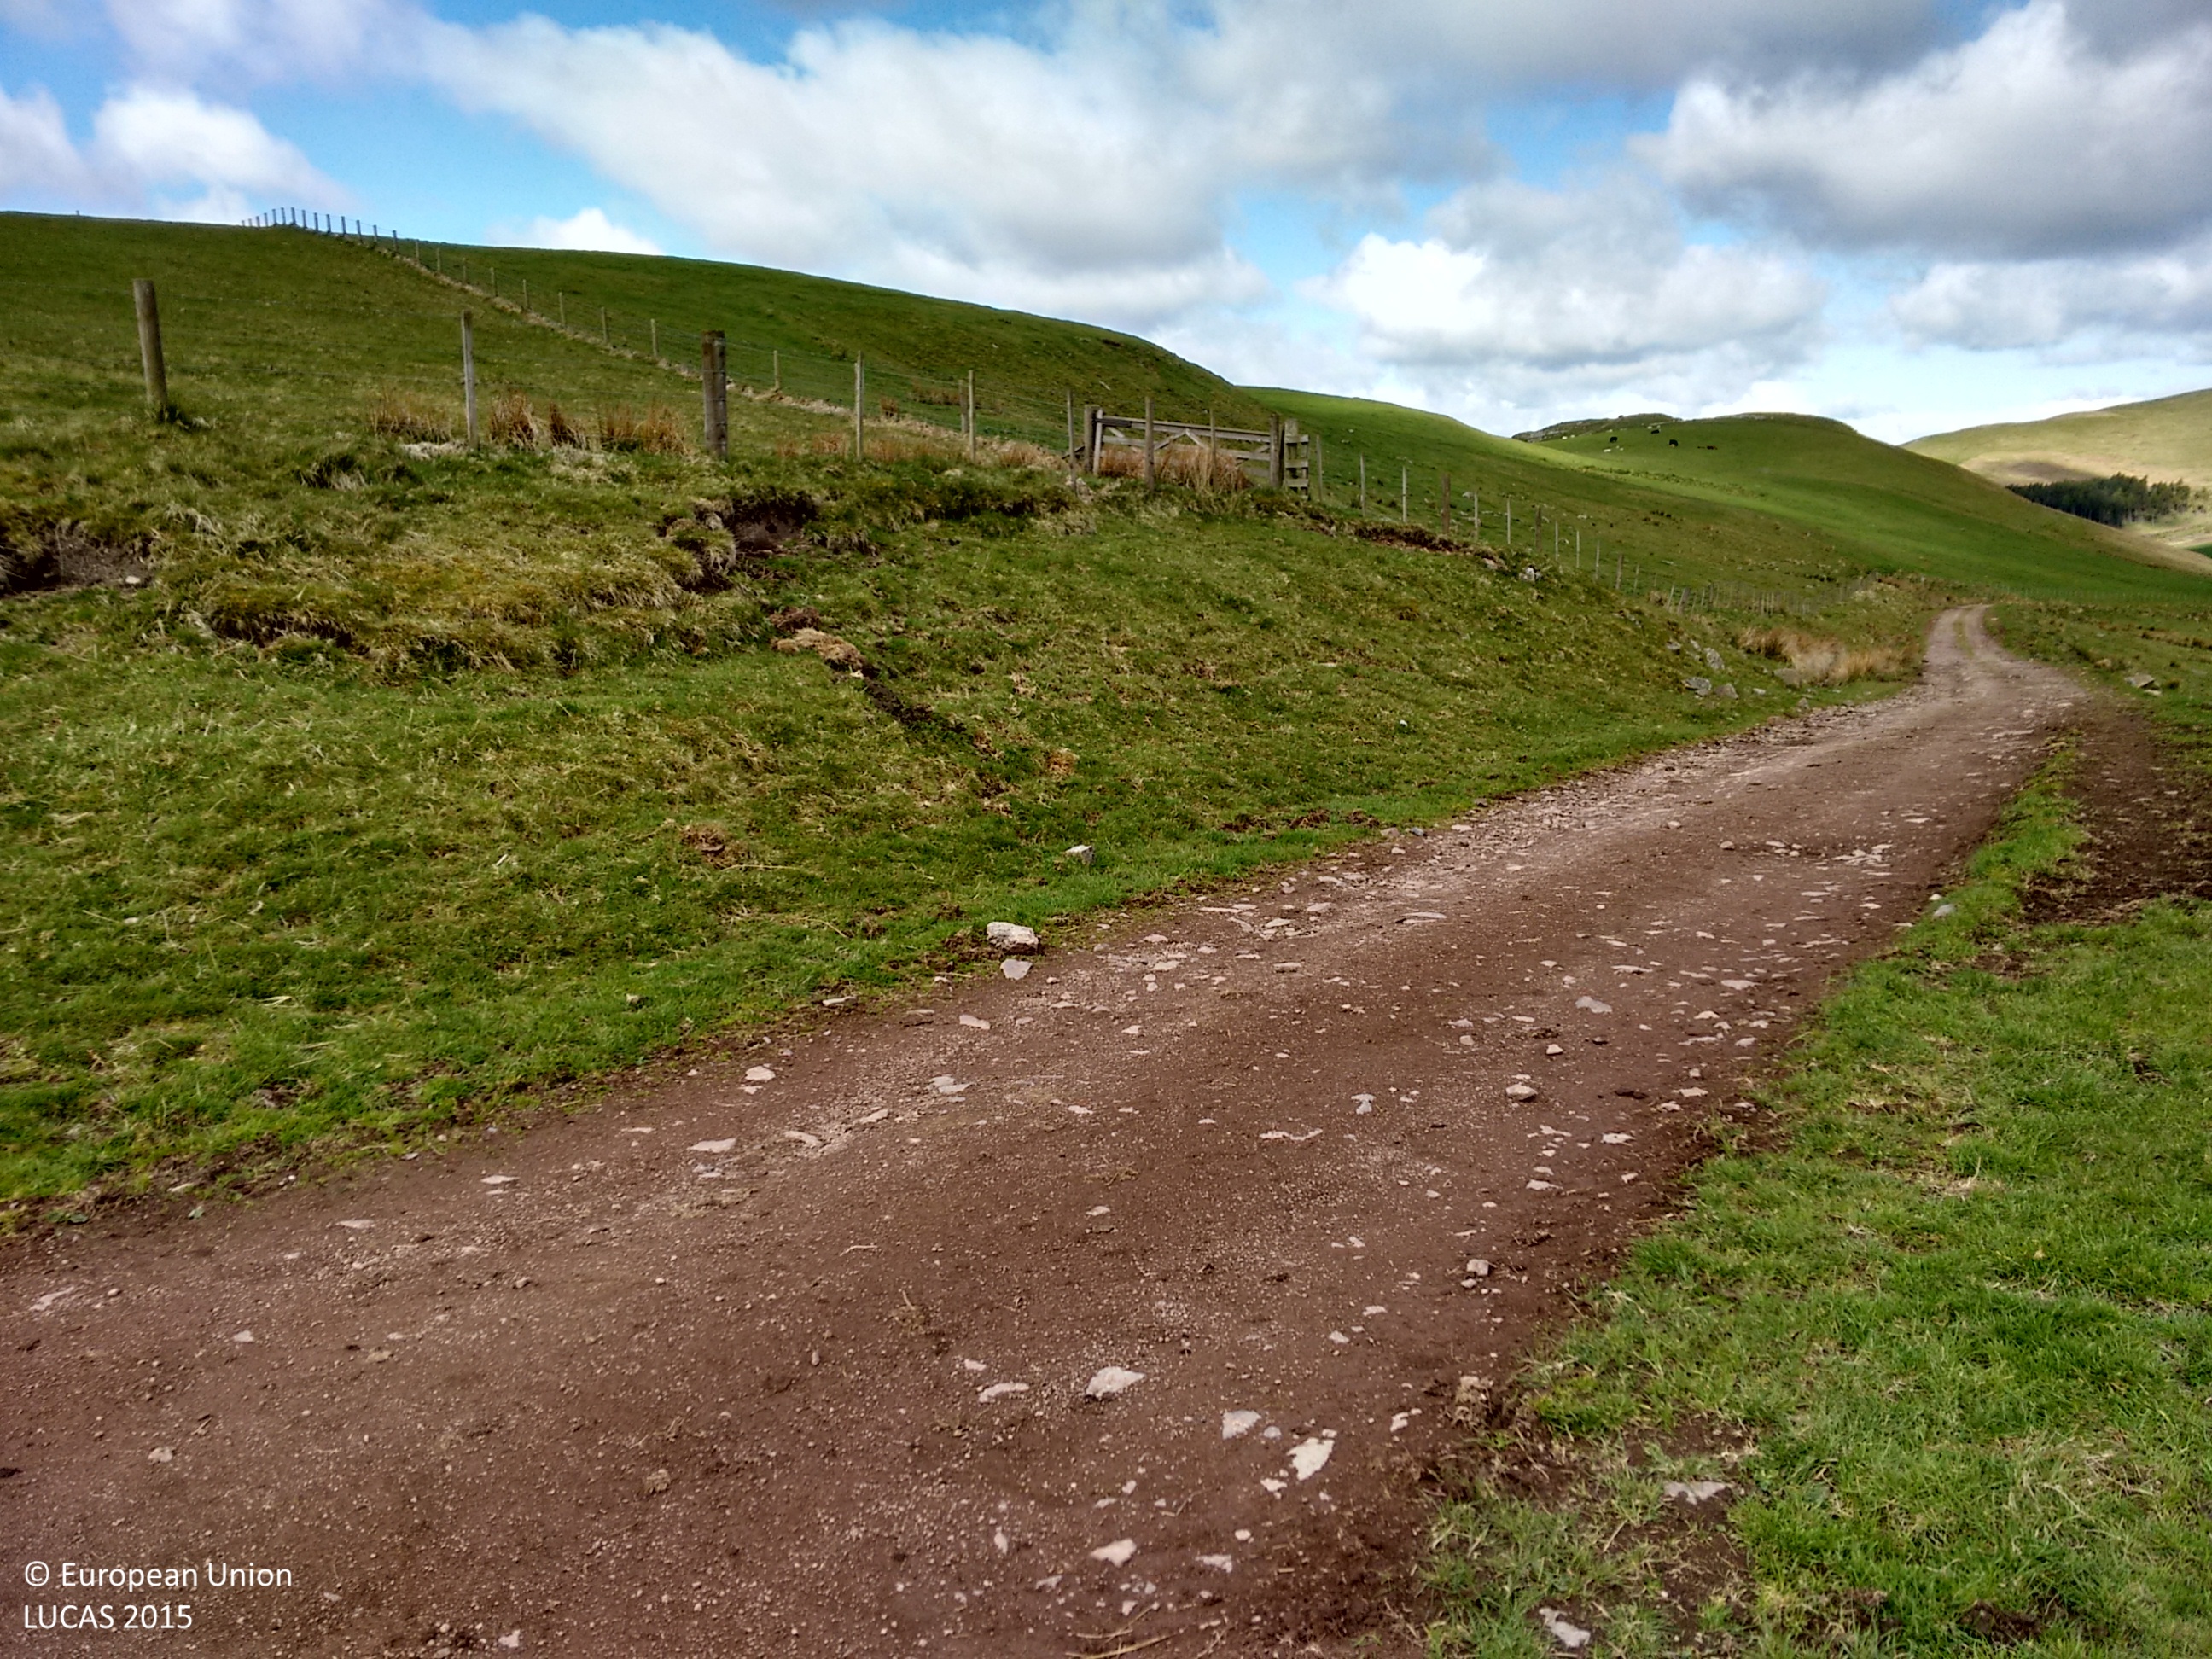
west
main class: Grassland
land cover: Grassland without tree/shrub cover
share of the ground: > 75 %
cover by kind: herbaceous plants 100 %
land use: Agriculture (excluding fallow land and kitchen gardens)
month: May
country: GB
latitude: 55.4734
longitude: -2.2222
